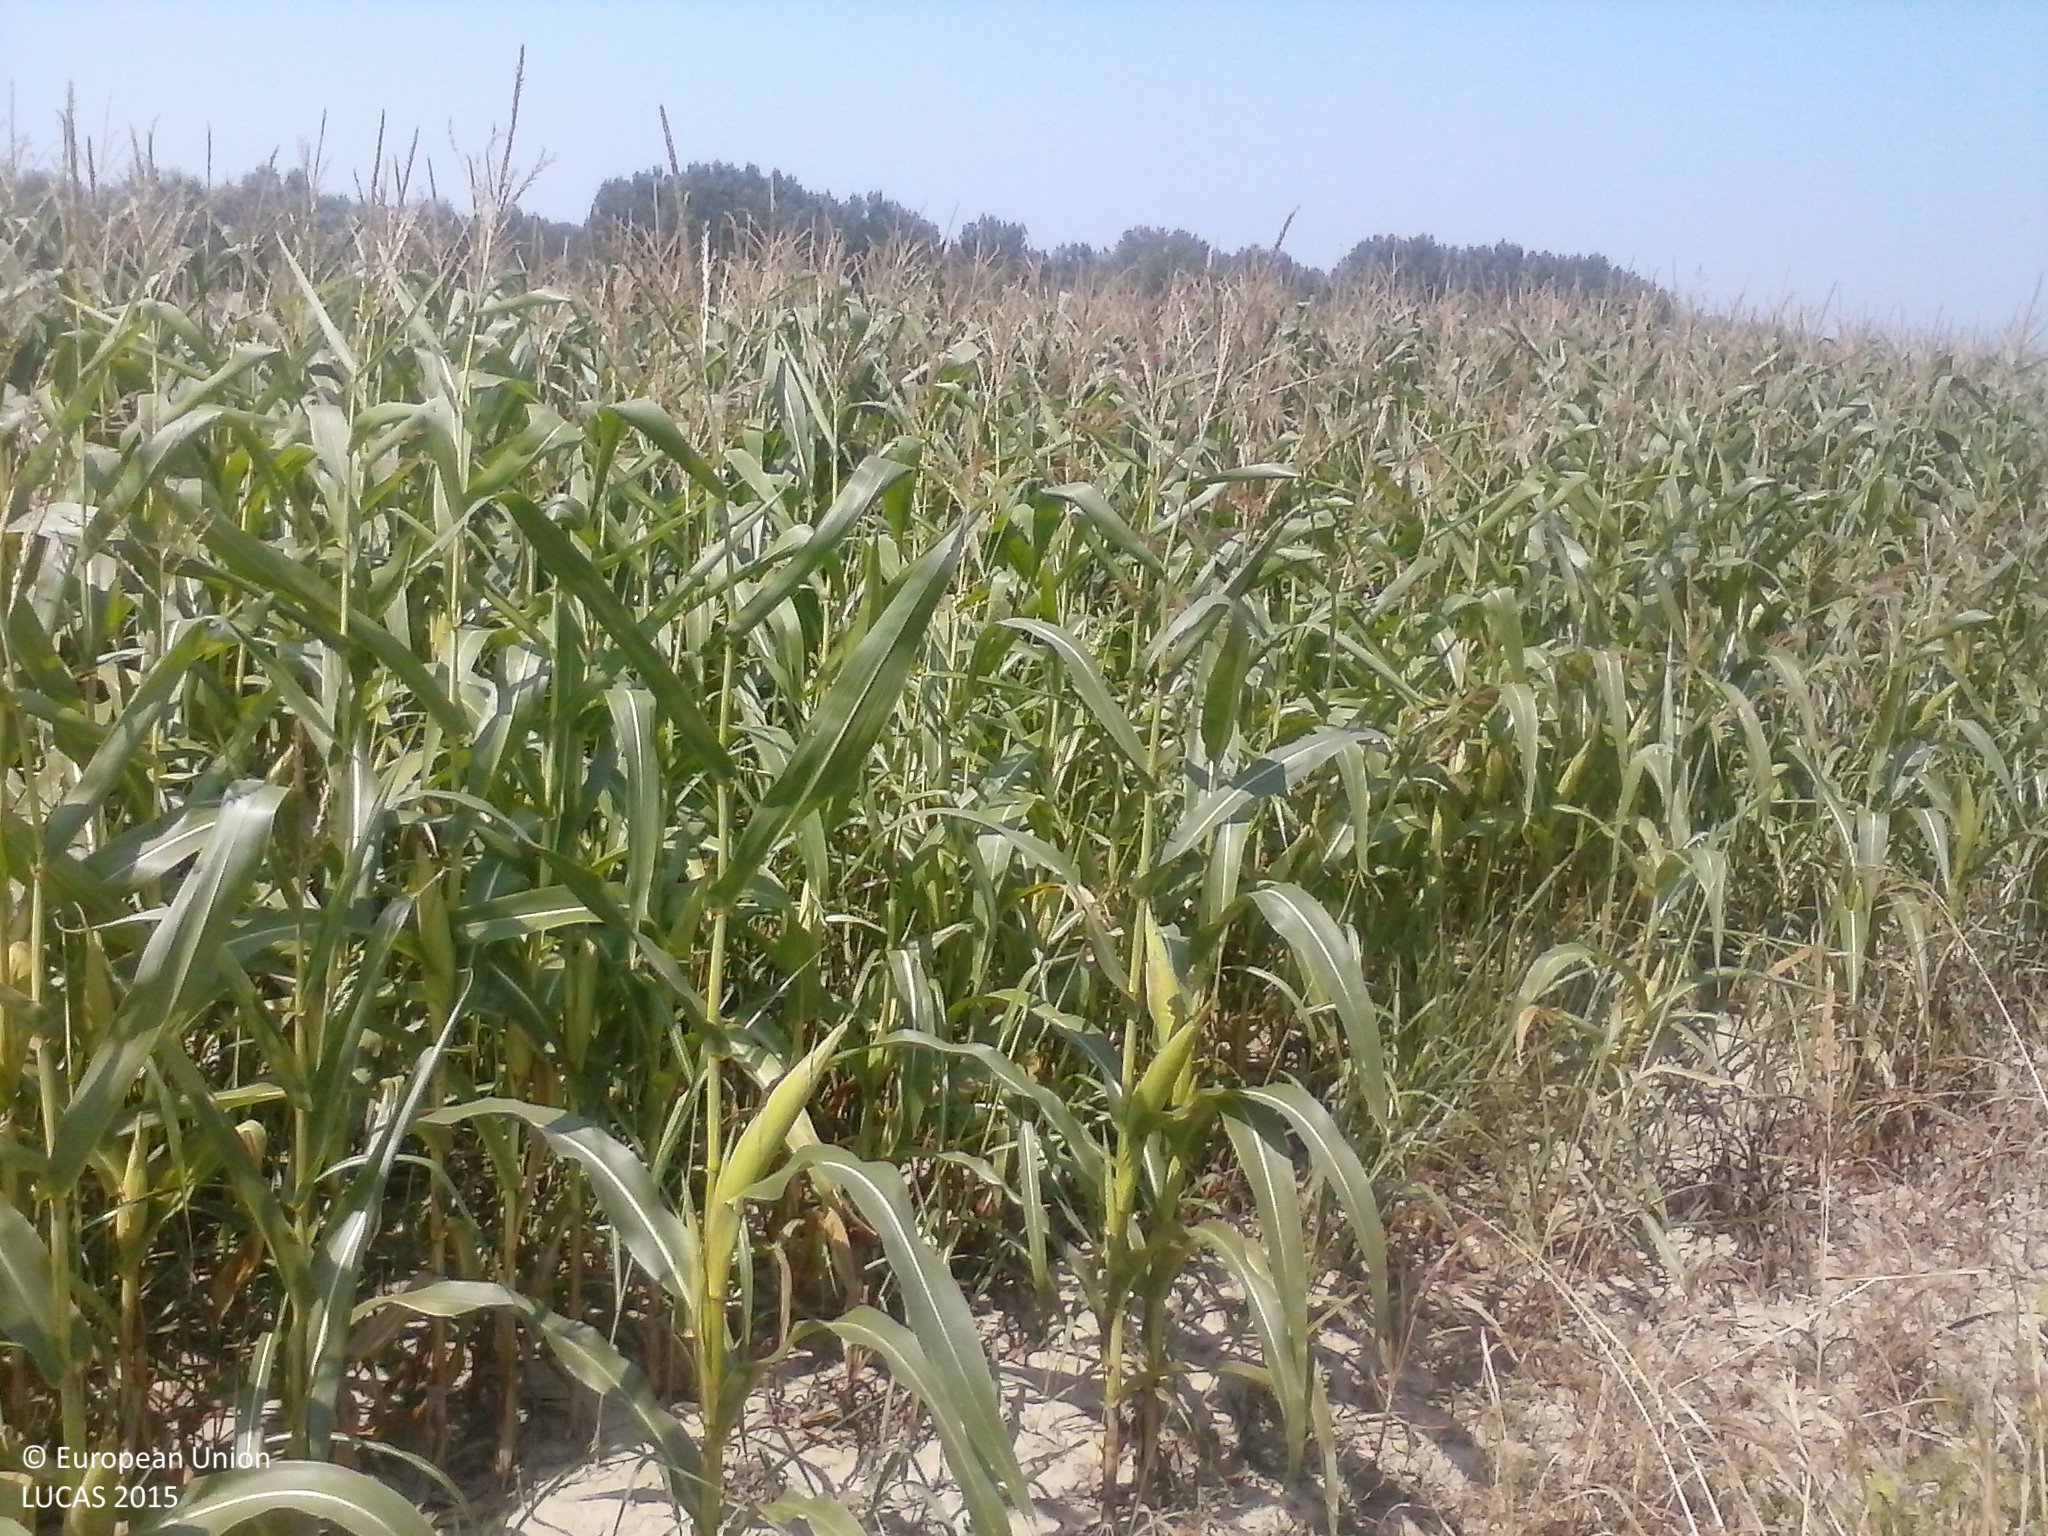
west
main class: Cropland
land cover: Maize
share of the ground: > 75 %
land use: Agriculture (excluding fallow land and kitchen gardens)
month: August
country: HU
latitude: 45.8785
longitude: 17.6439
